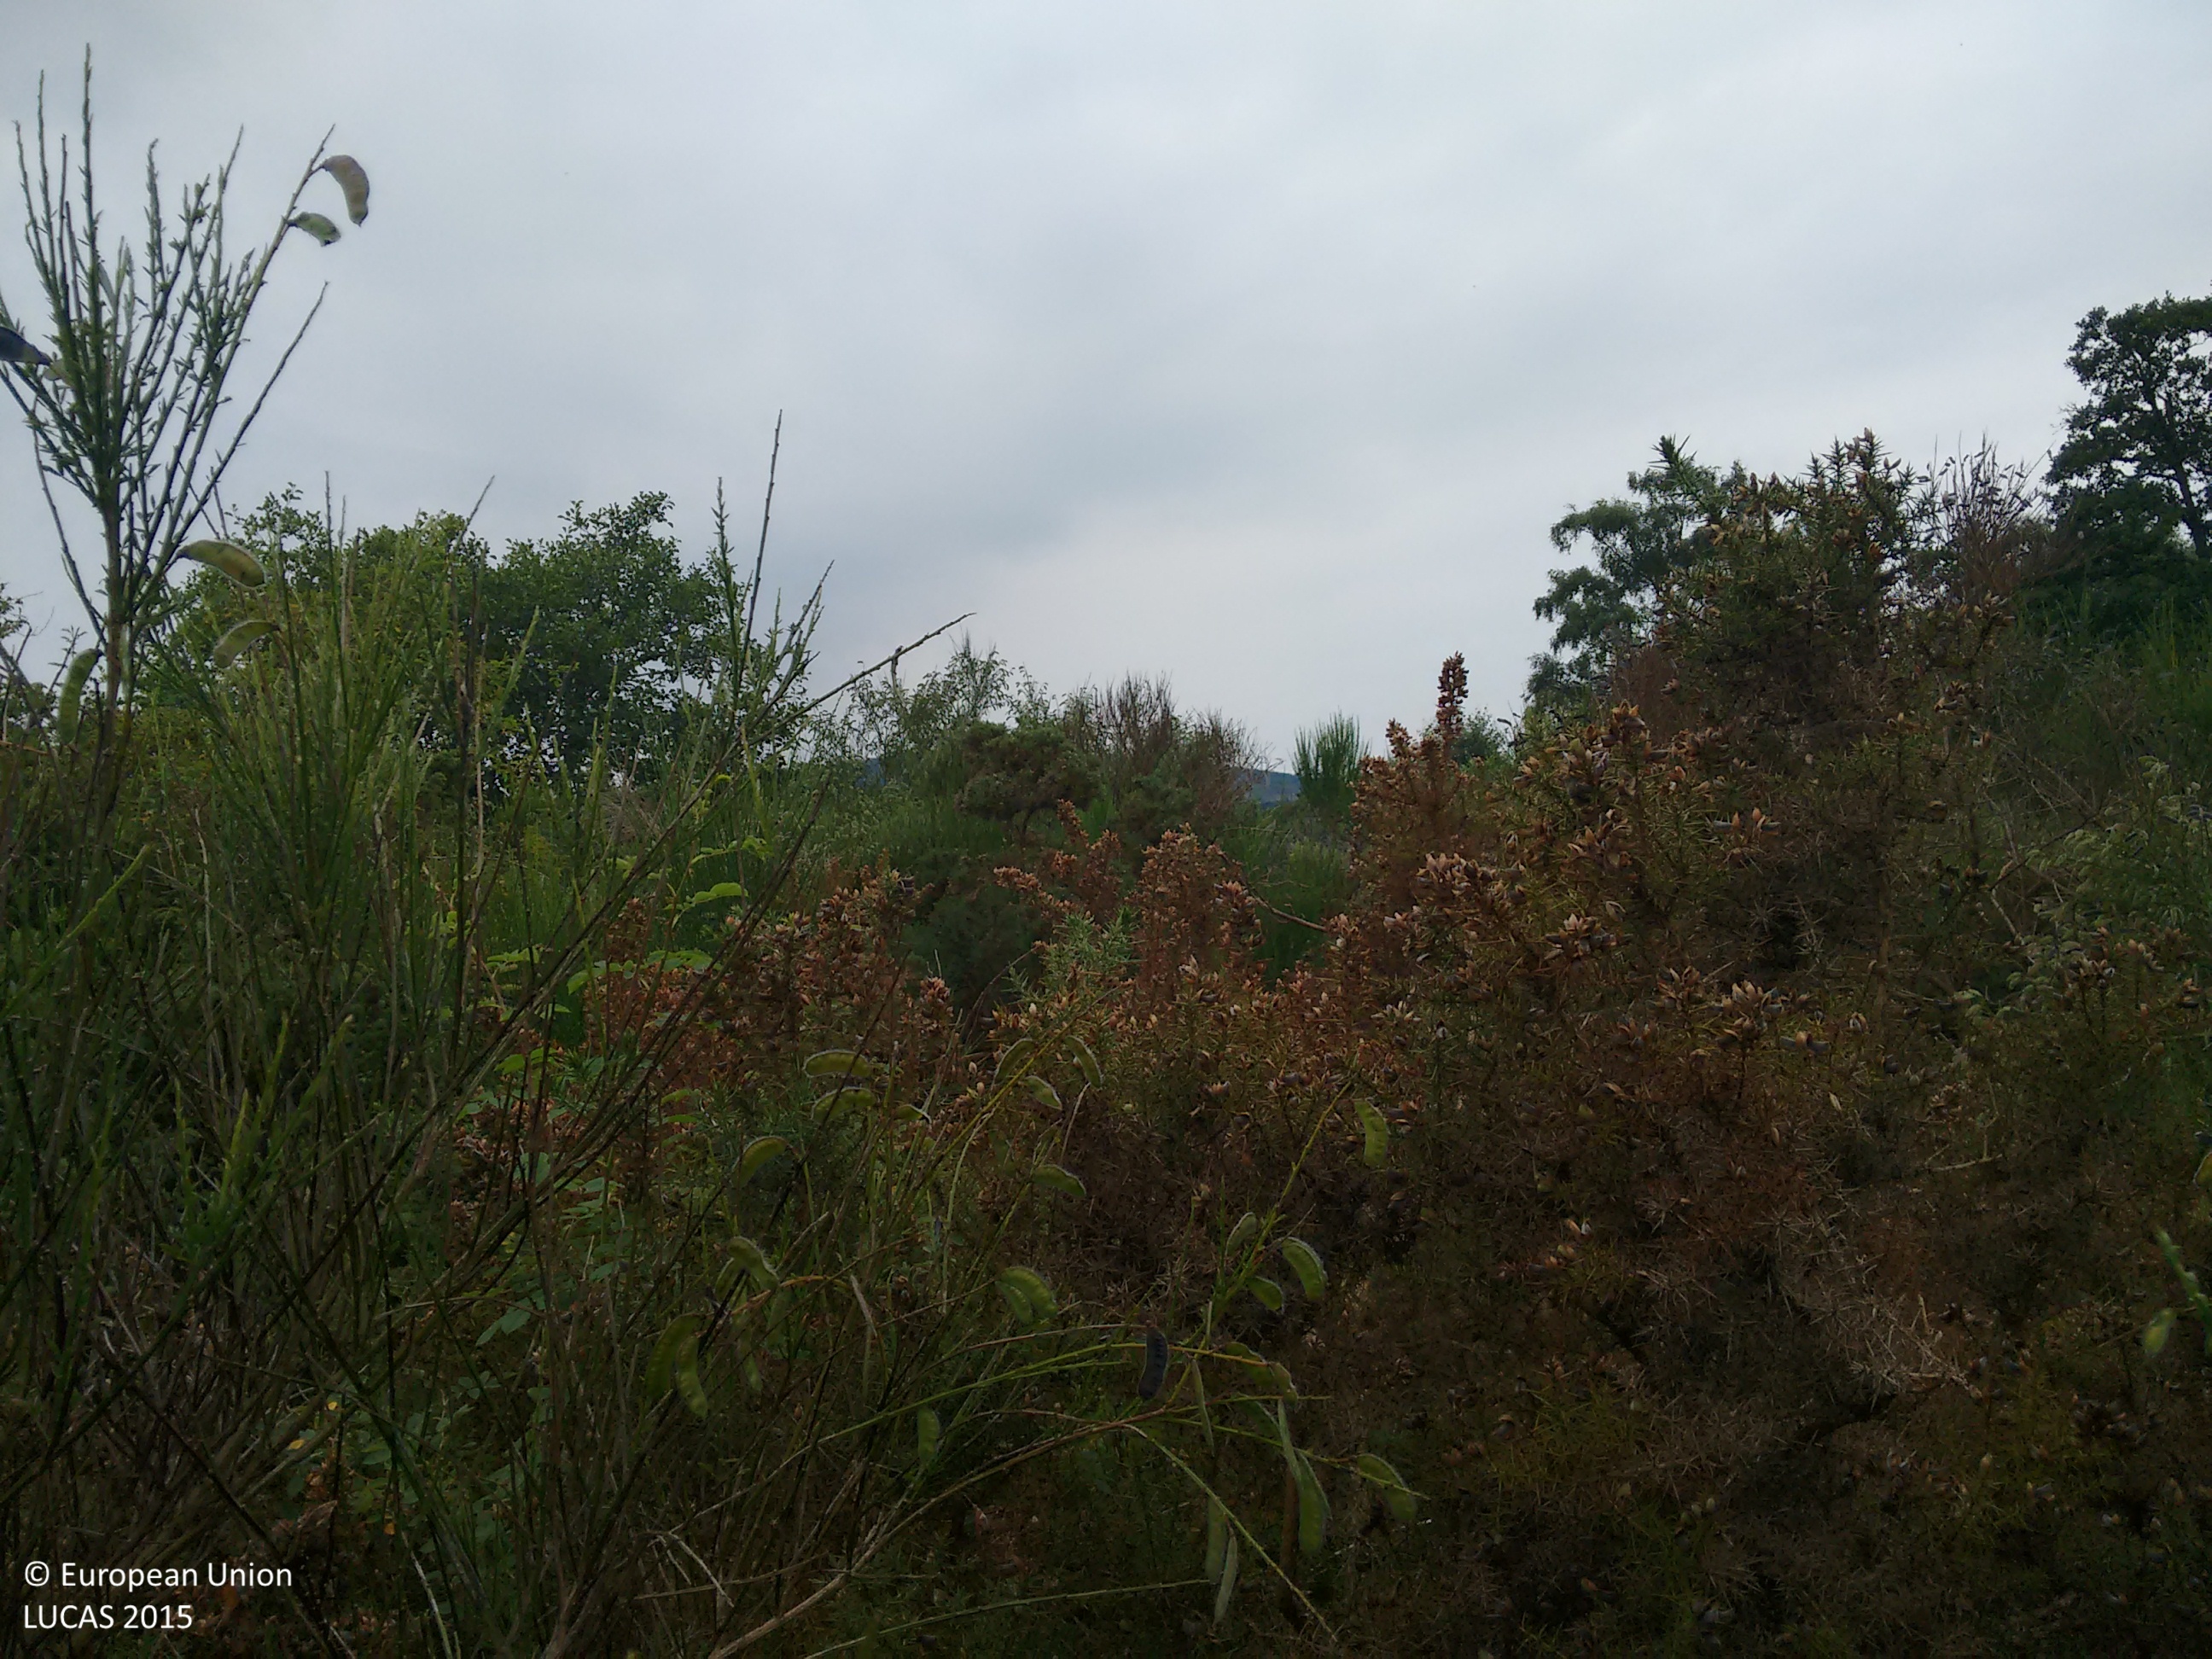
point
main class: Shrubland
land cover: Shrubland with sparse tree cover
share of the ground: > 75 %
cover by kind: shrubs 85 %, herbaceous plants 10 %, coniferous forest trees 5 %
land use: Agriculture (excluding fallow land and kitchen gardens)
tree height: > 5 m
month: August
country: GB
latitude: 57.5363
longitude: -4.5064
